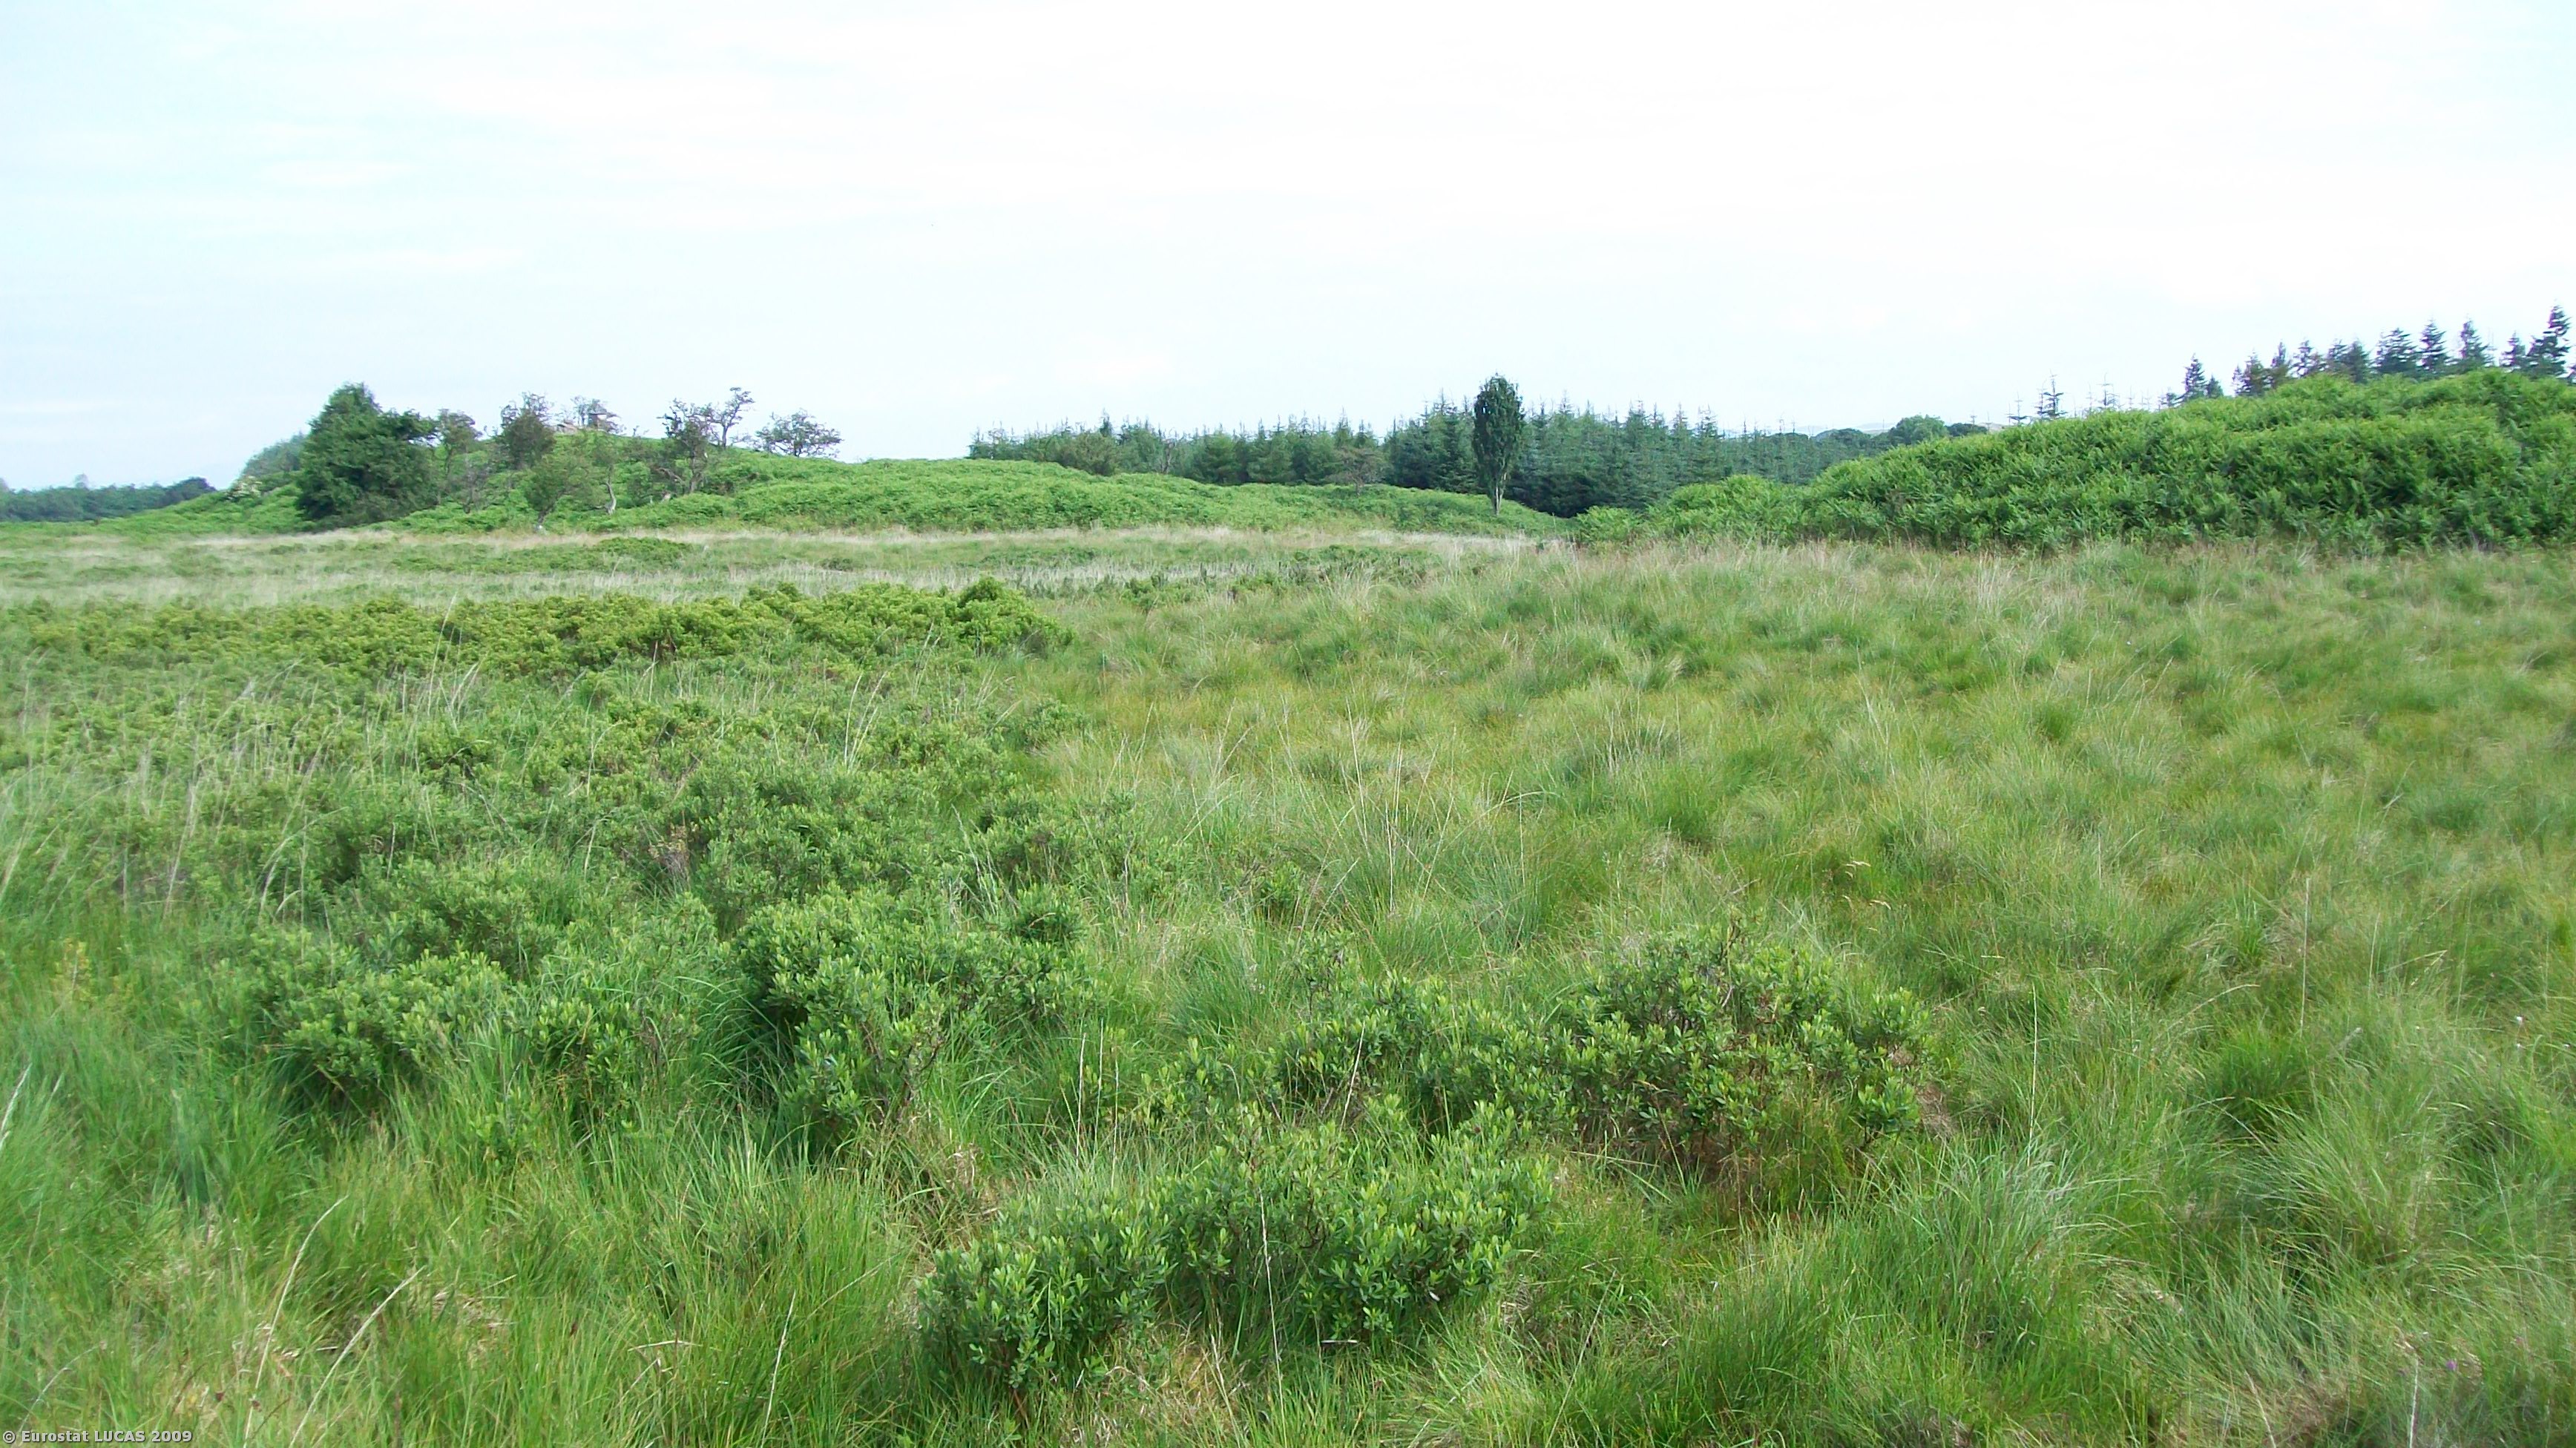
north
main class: Grassland
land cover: Grassland without tree/shrub cover
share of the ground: > 75 %
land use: Agriculture (excluding fallow land and kitchen gardens)
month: July
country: GB
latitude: 55.0208
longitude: -4.0914
